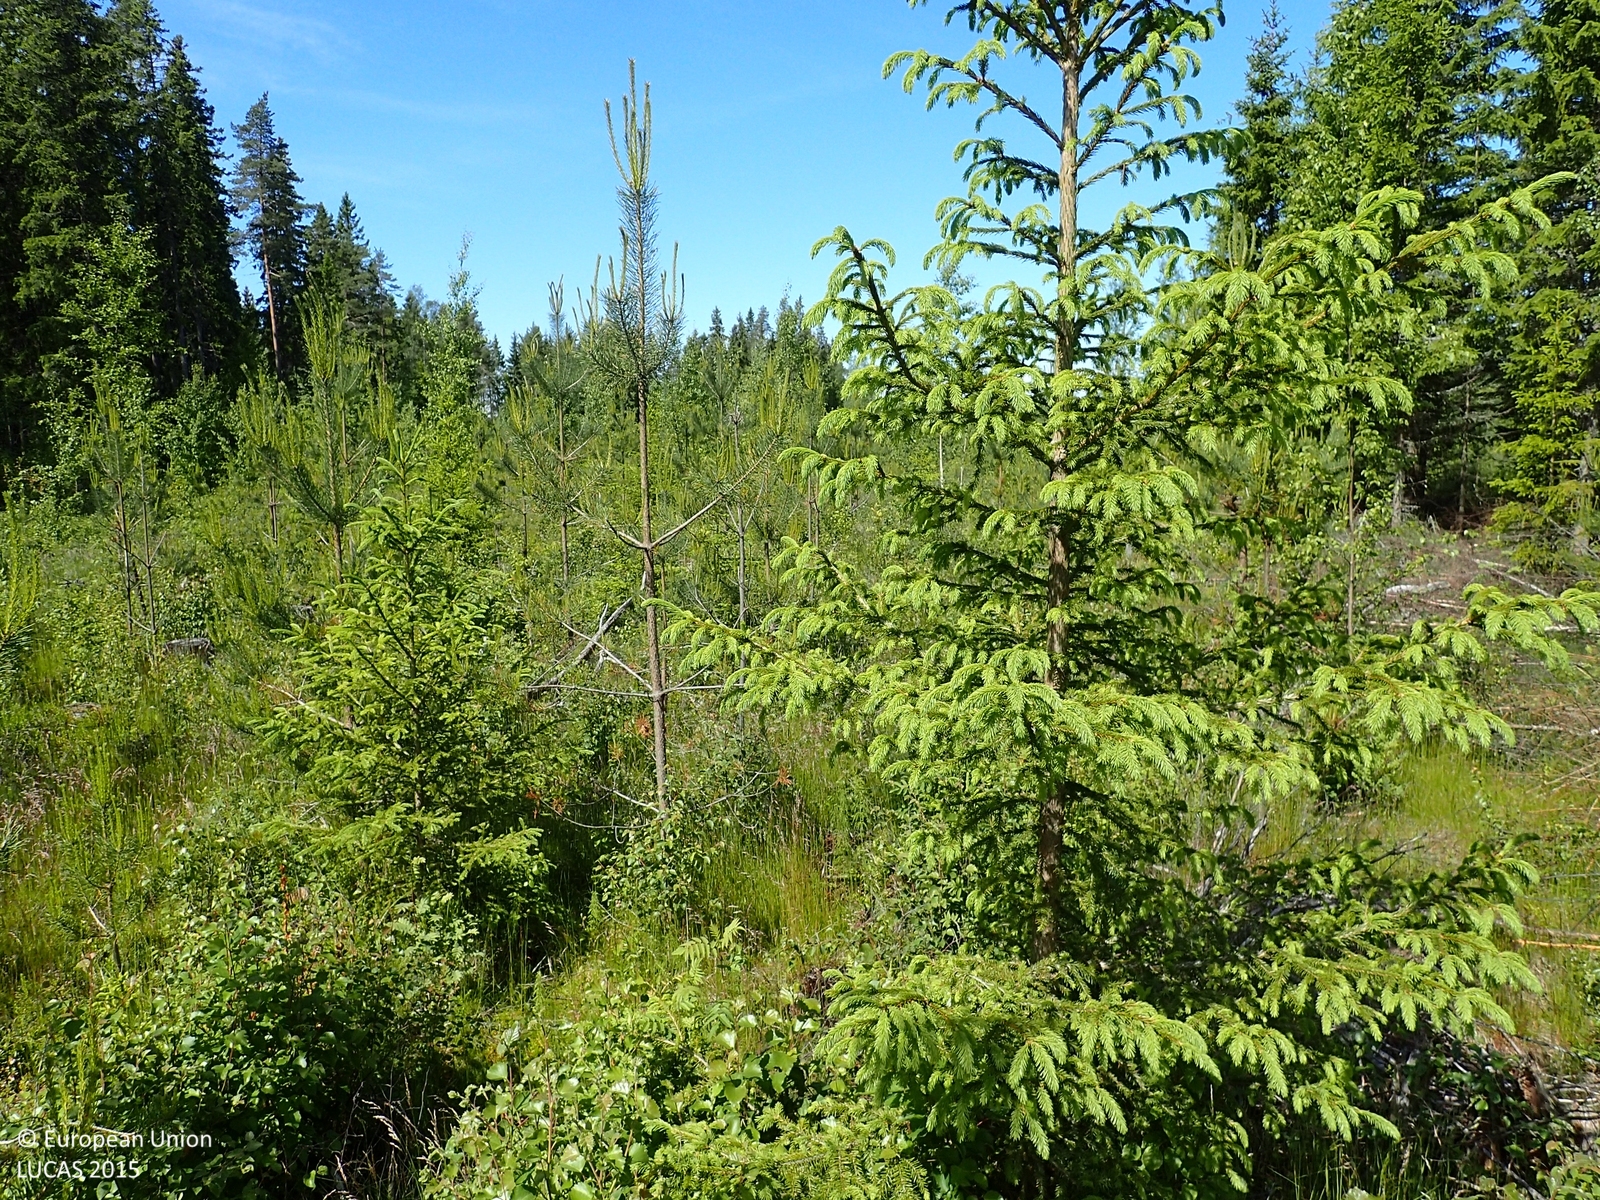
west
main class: Woodland
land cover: Pine dominated mixed woodland
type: boreal forest
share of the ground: 25 - 50 %
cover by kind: herbaceous plants 60 %, coniferous forest trees 15 %, broadleaved forest trees 15 %, shrubs 10 %
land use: Forestry
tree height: < 5 m
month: June
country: FI
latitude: 62.3794
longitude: 21.3924
